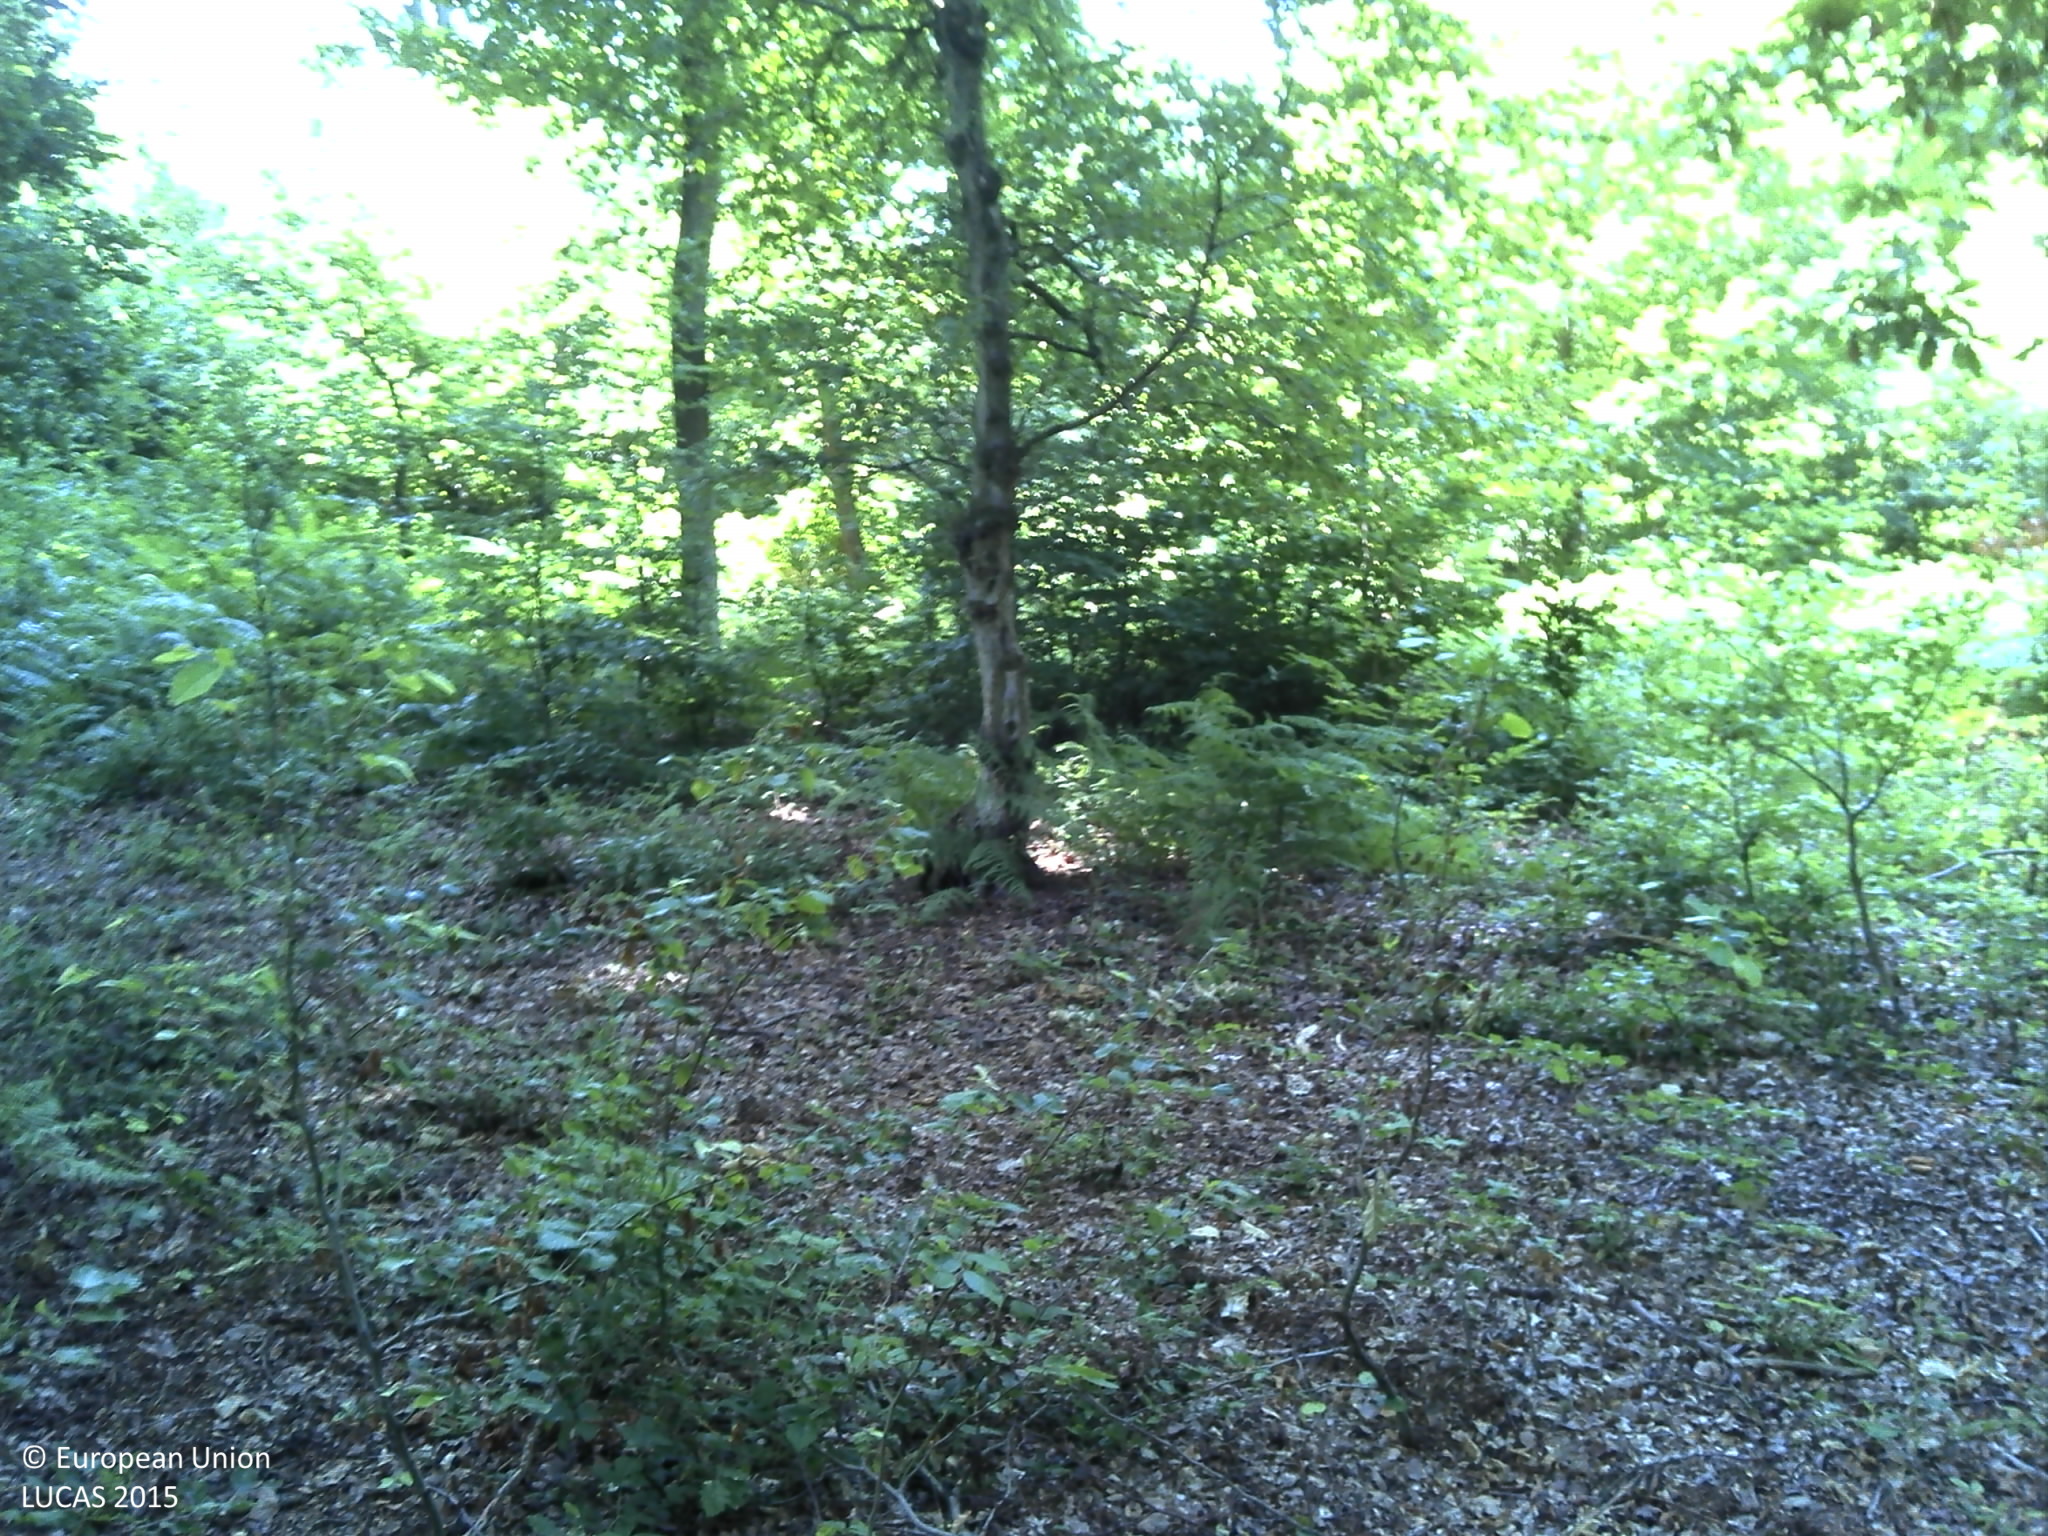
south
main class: Woodland
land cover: Broadleaved woodland
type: acidophilous oak and oak-birch forest
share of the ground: > 75 %
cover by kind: broadleaved forest trees 100 %
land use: Forestry
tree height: > 5 m
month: June
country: FR
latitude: 49.4297
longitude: 1.0017
